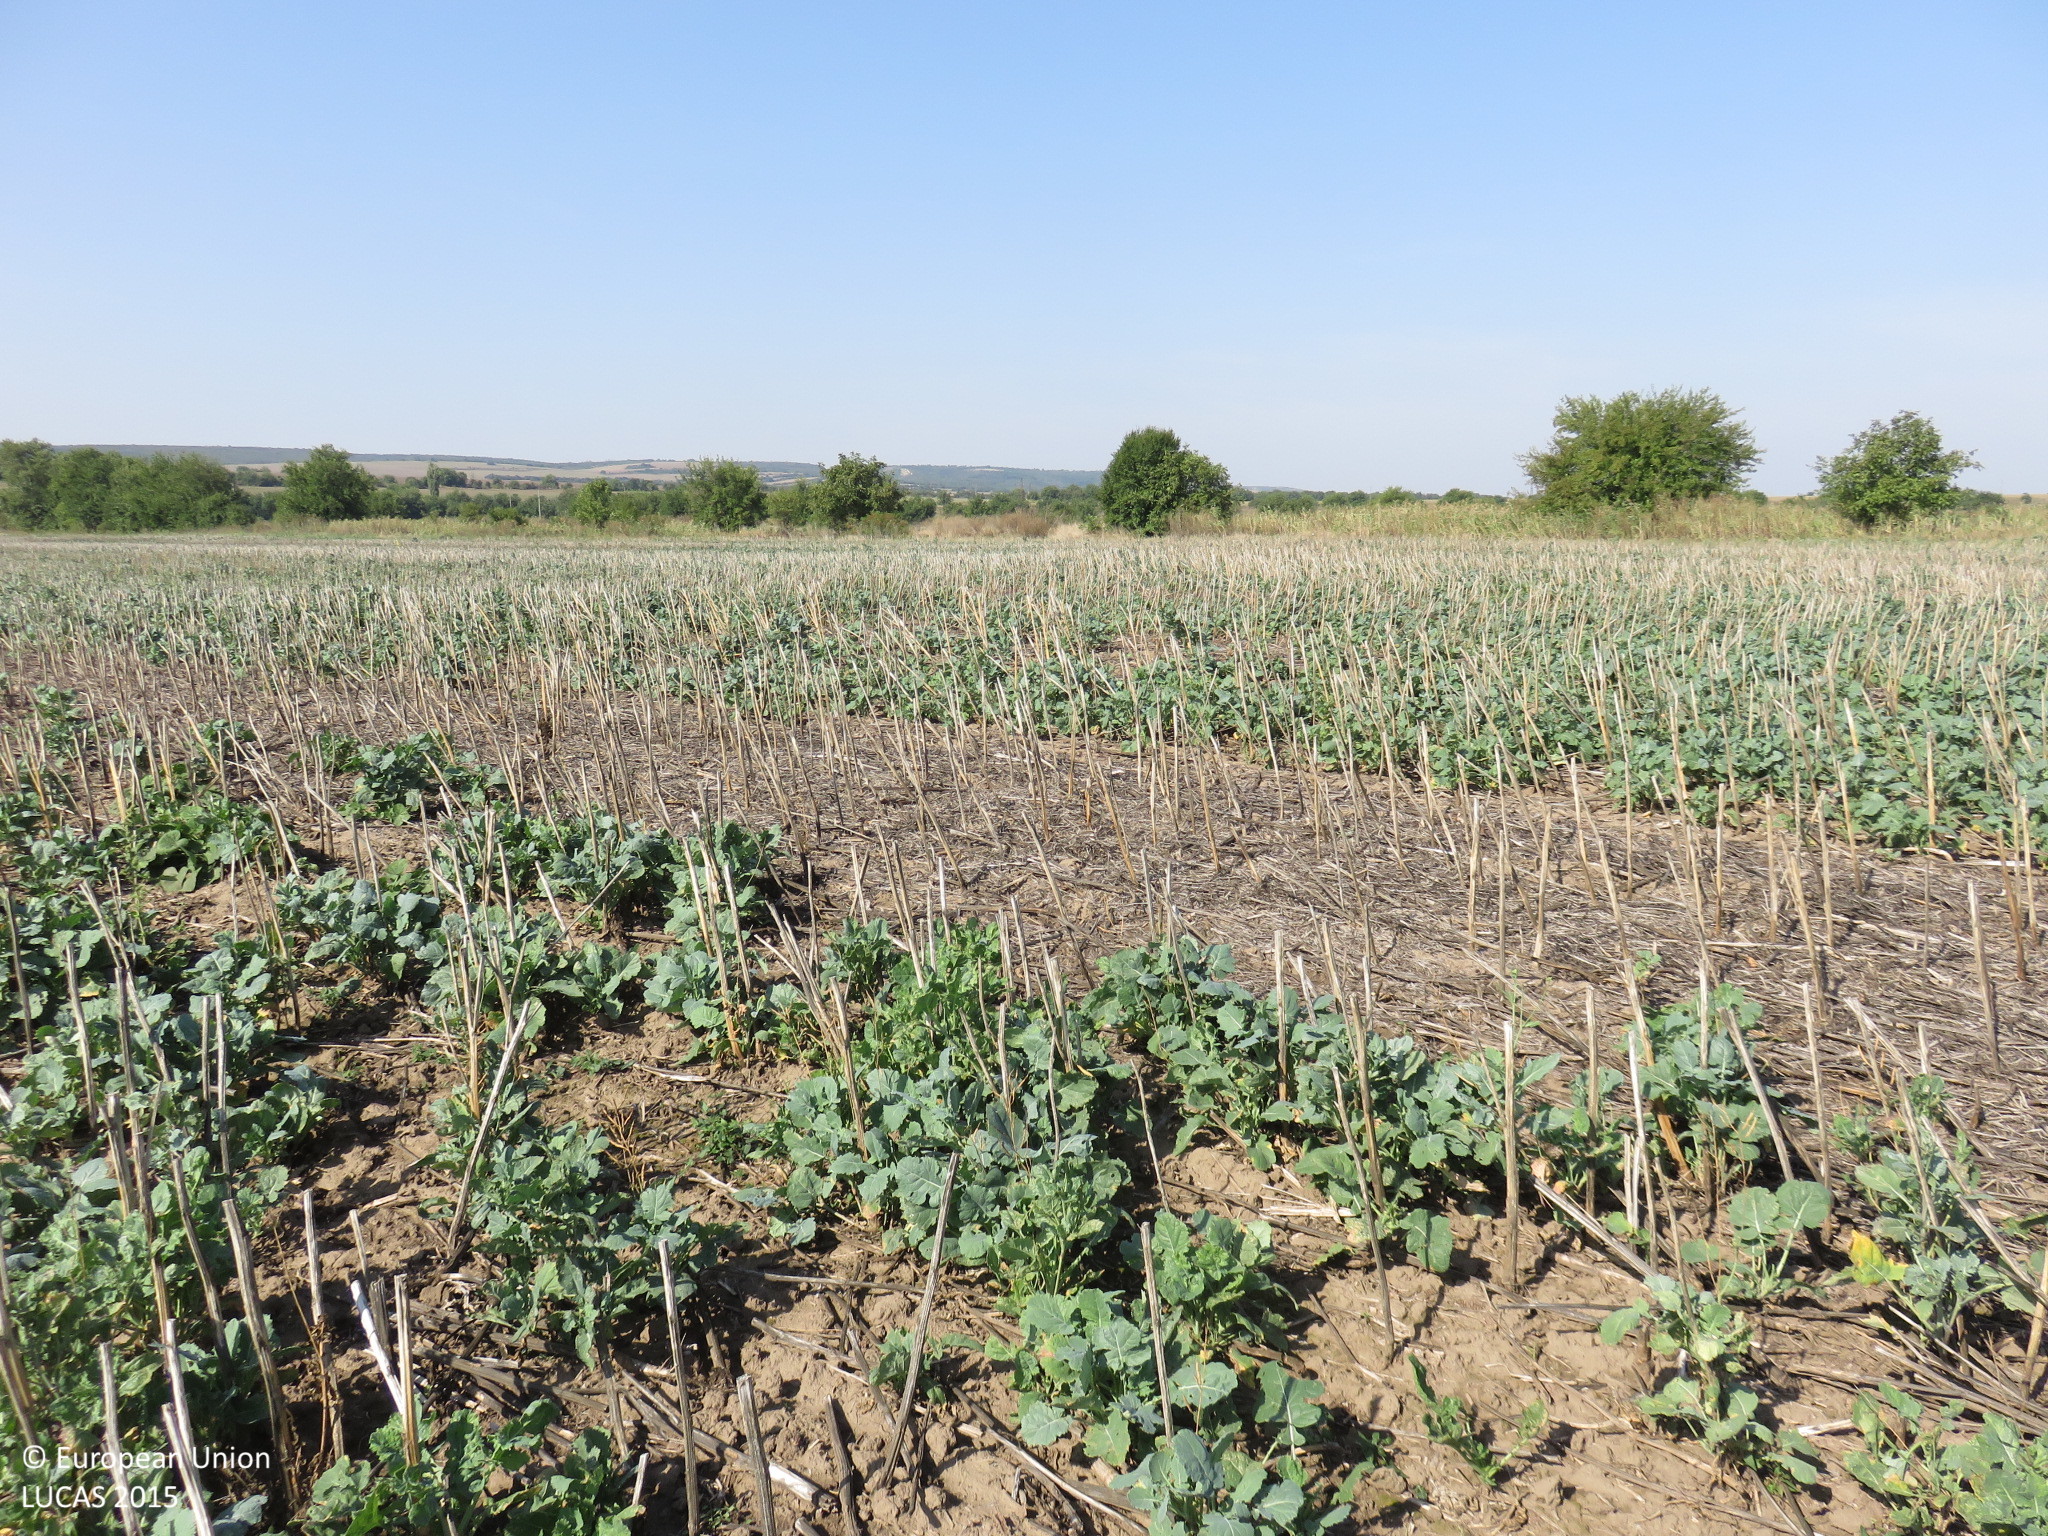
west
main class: Cropland
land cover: Rape and turnip rape
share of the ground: 50 - 75 %
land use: Agriculture (excluding fallow land and kitchen gardens)
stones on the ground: < 10 %
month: September
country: BG
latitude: 43.6647
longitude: 24.5615
